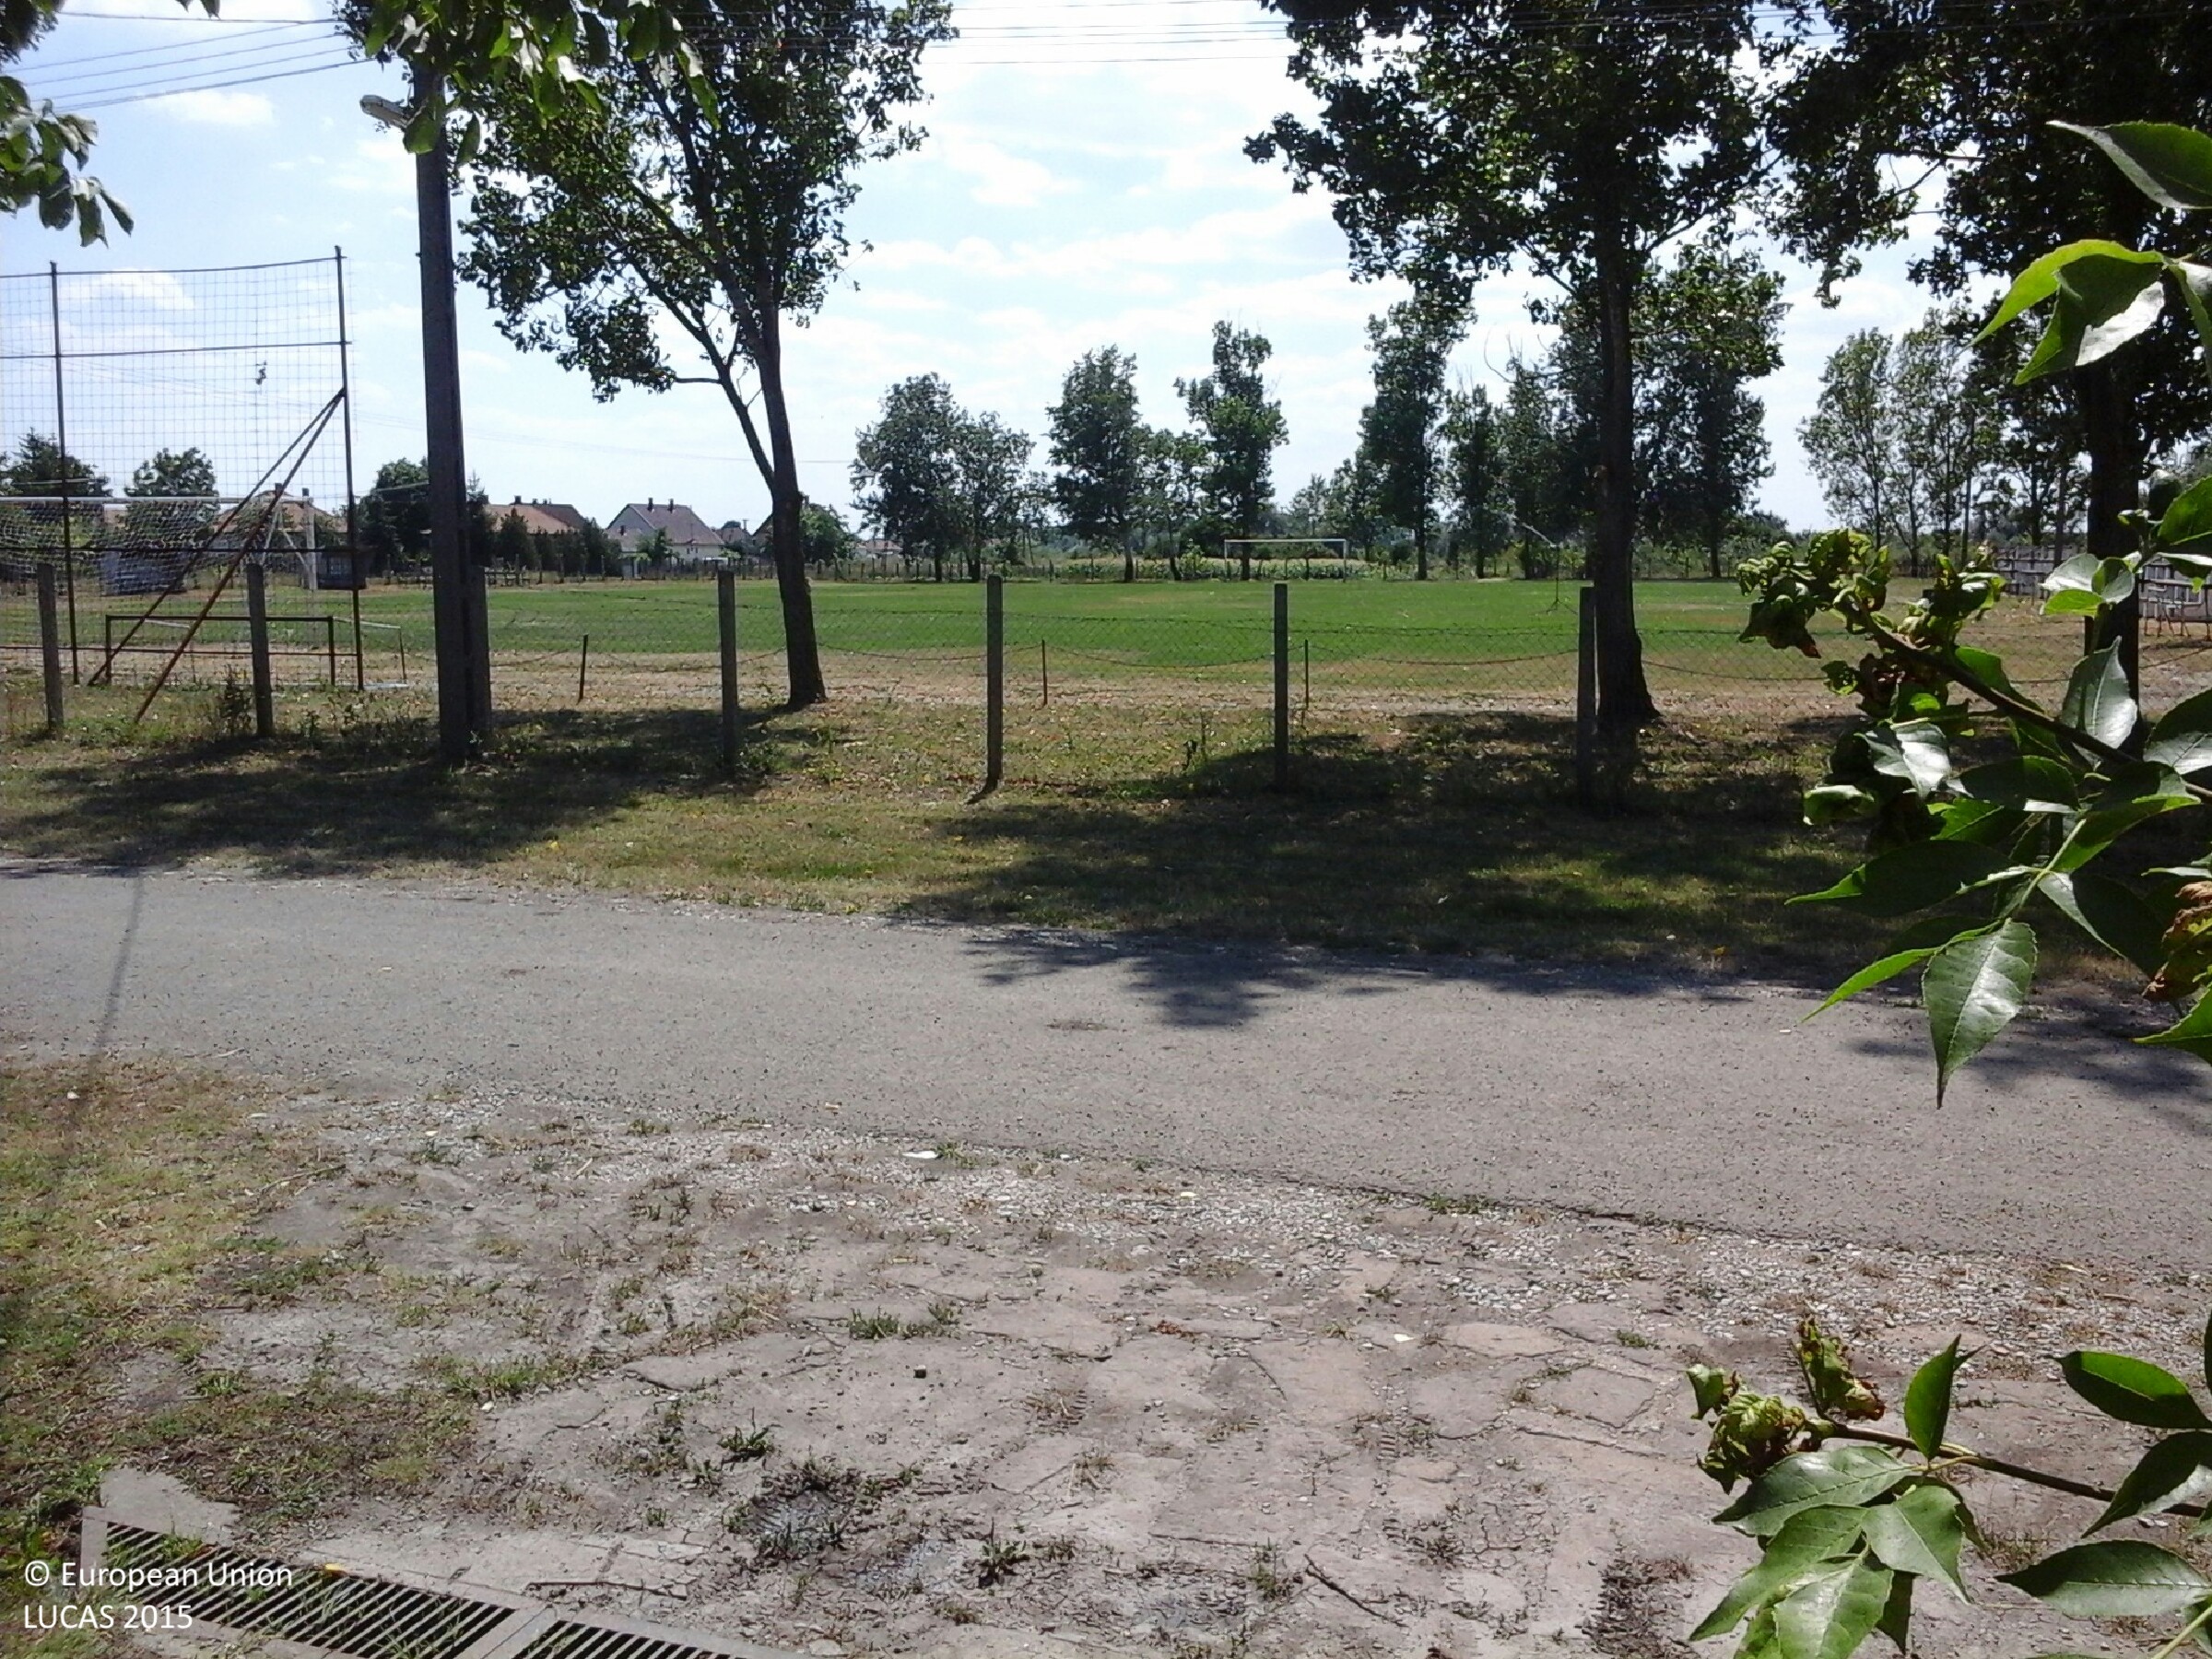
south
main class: Grassland
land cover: Grassland without tree/shrub cover
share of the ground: > 75 %
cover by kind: herbaceous plants 100 %
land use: Residential
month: July
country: HU
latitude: 47.6522
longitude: 20.6442
